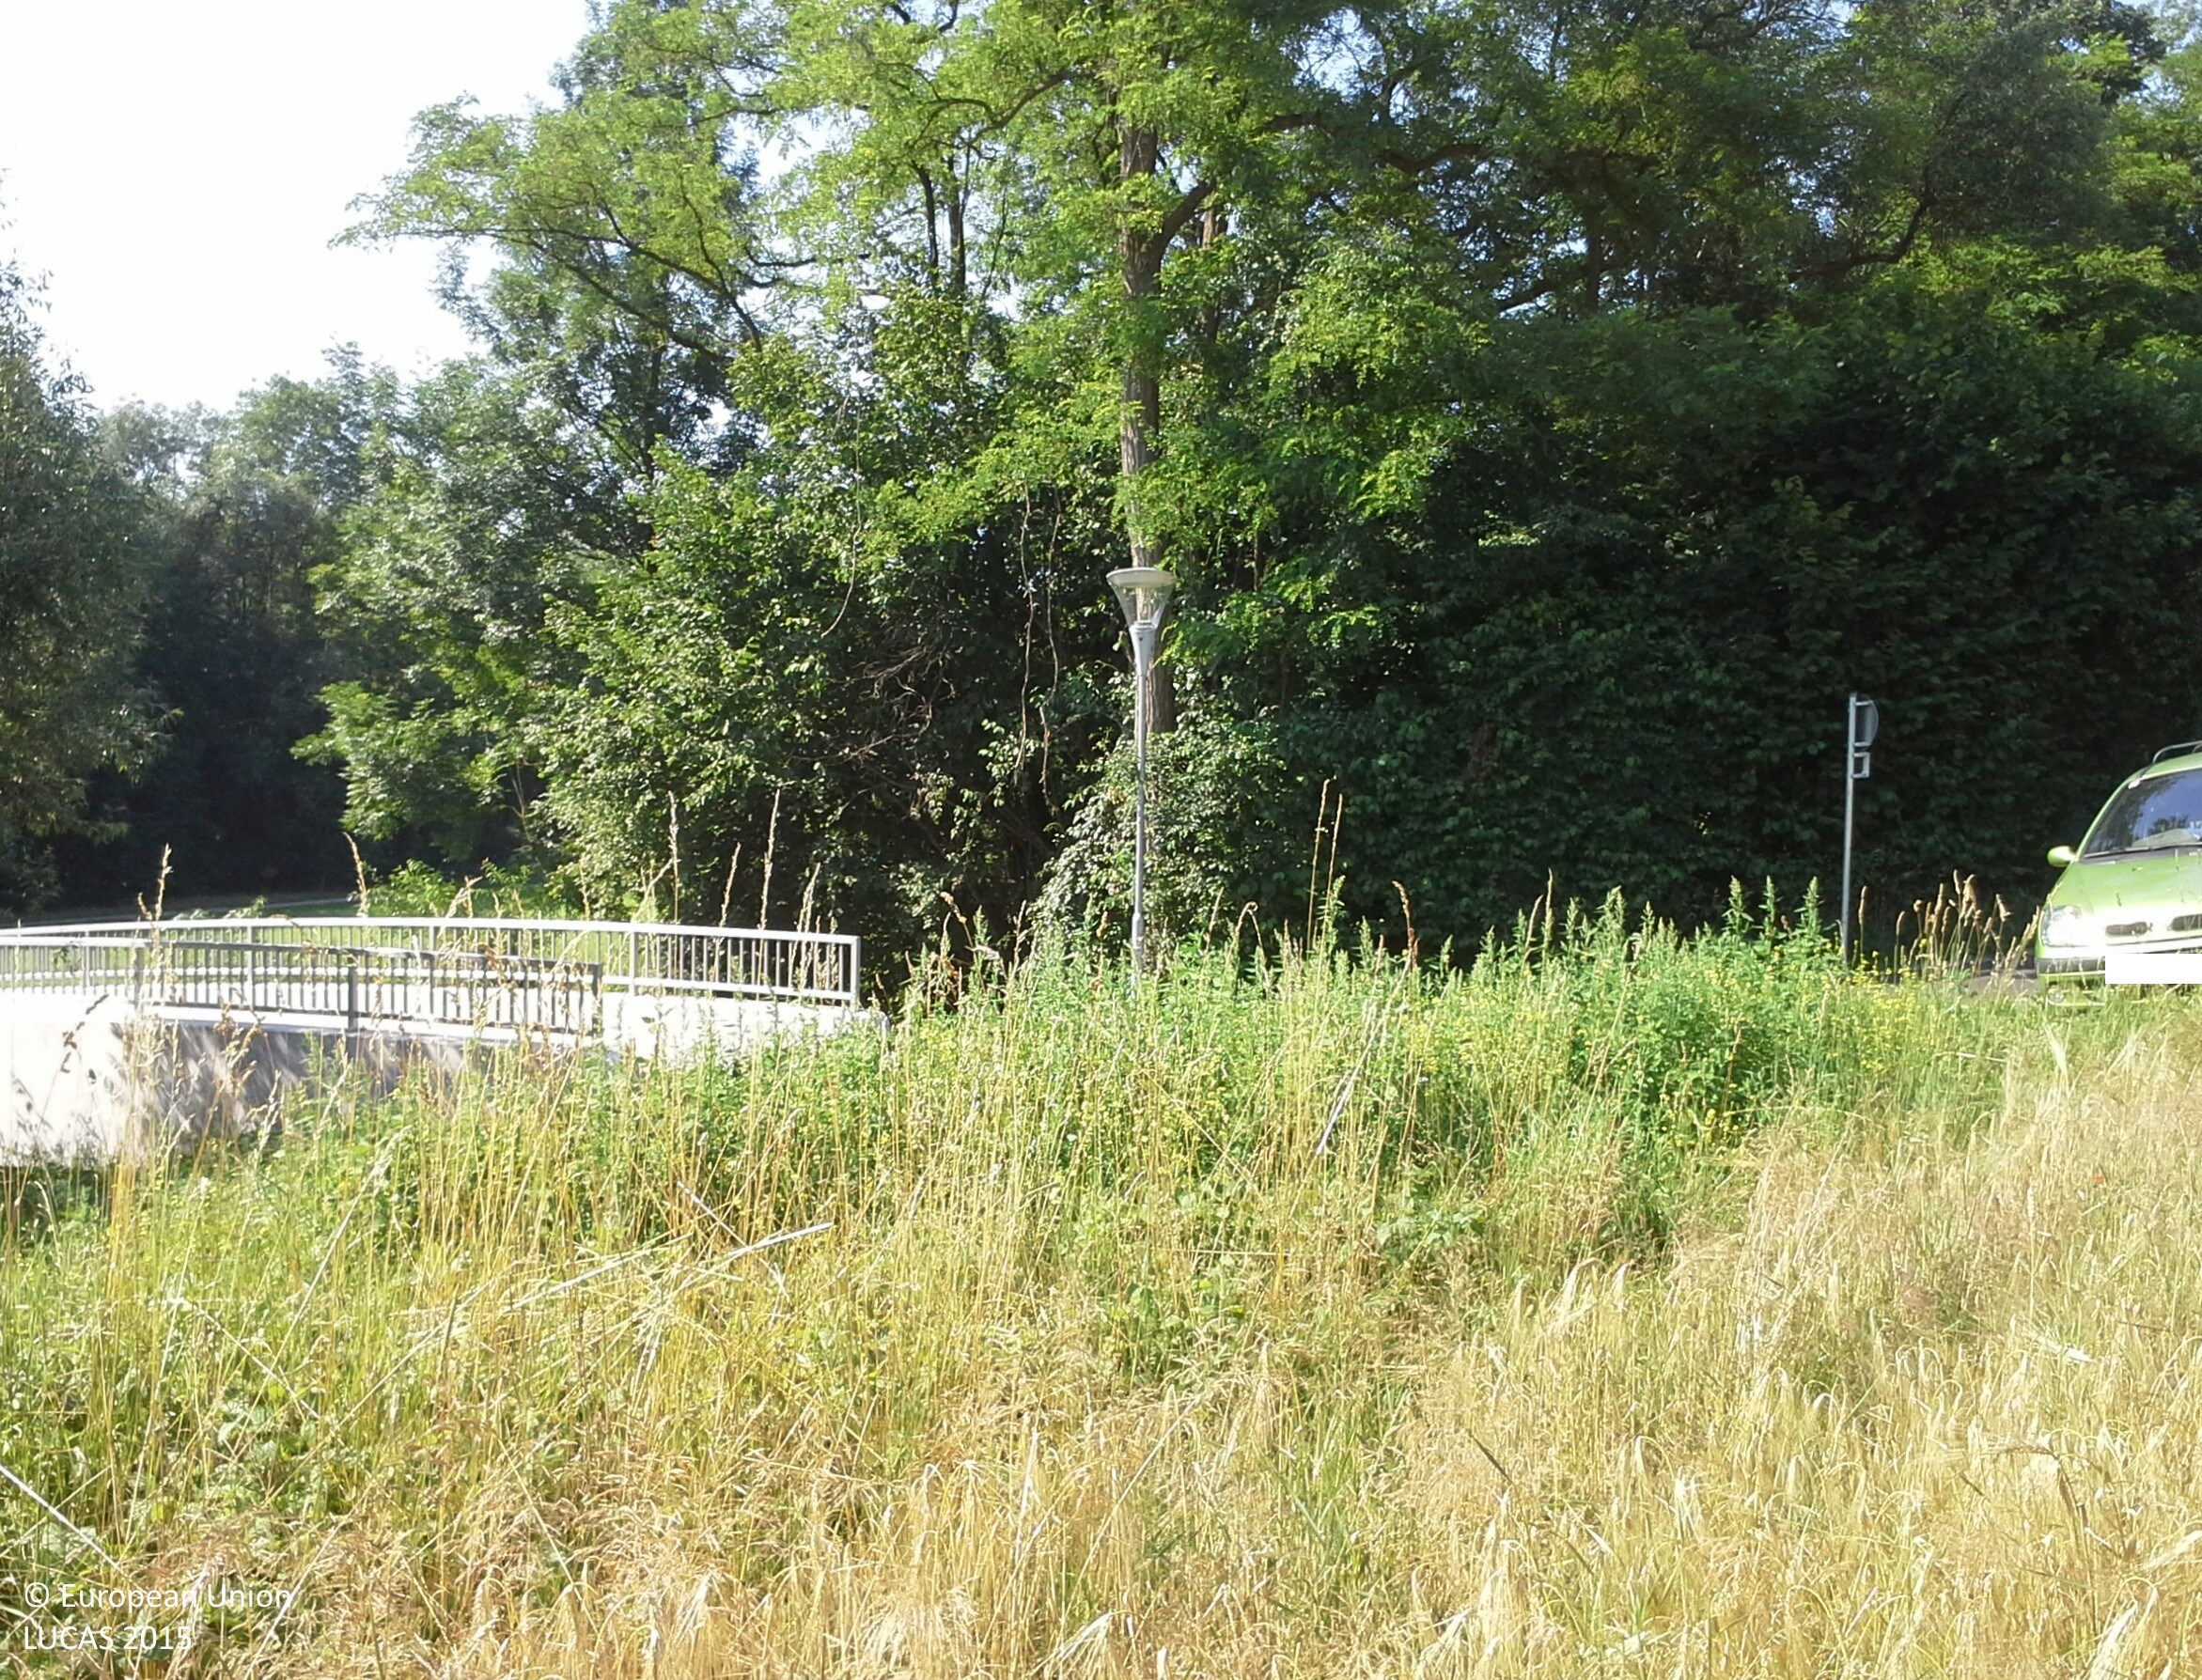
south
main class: Cropland
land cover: Barley
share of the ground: > 75 %
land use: Agriculture (excluding fallow land and kitchen gardens)
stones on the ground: 25 - 50 %
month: July
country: AT
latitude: 48.1168
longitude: 14.8500
